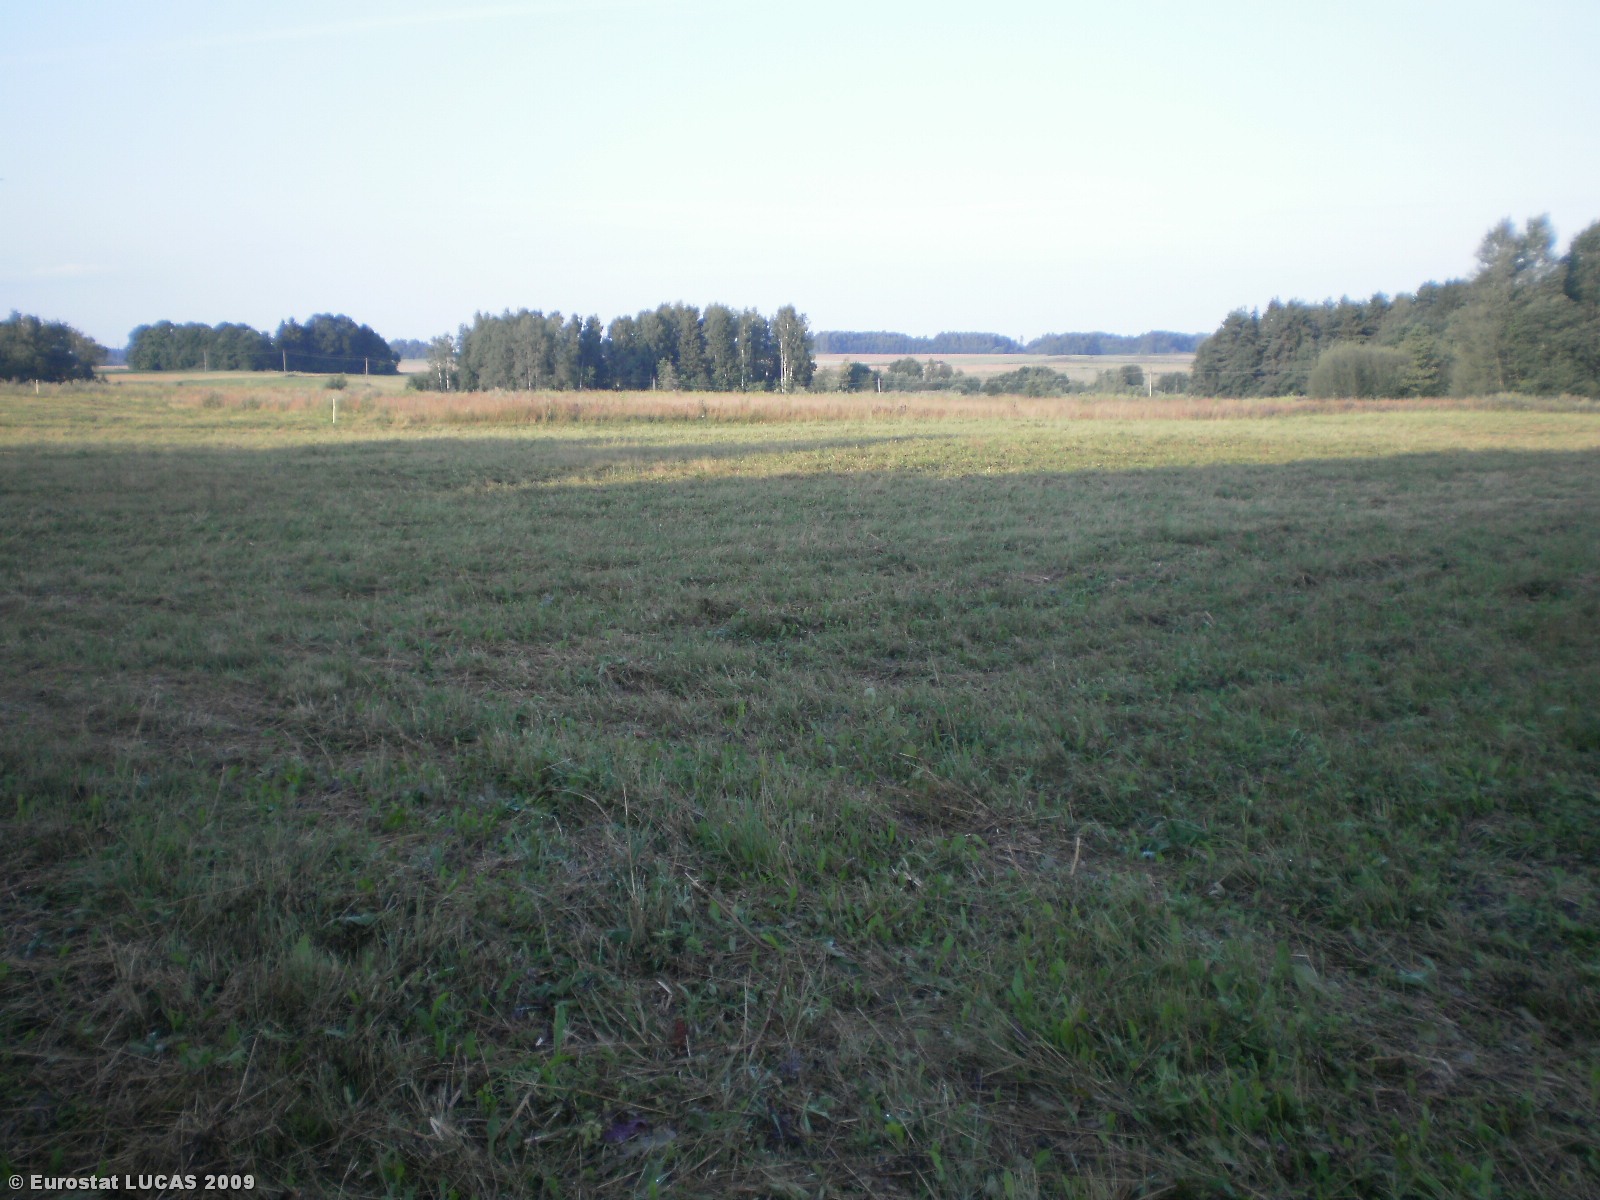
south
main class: Grassland
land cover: Grassland without tree/shrub cover
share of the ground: > 75 %
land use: Agriculture (excluding fallow land and kitchen gardens)
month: July
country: LT
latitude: 55.9011
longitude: 25.6241
